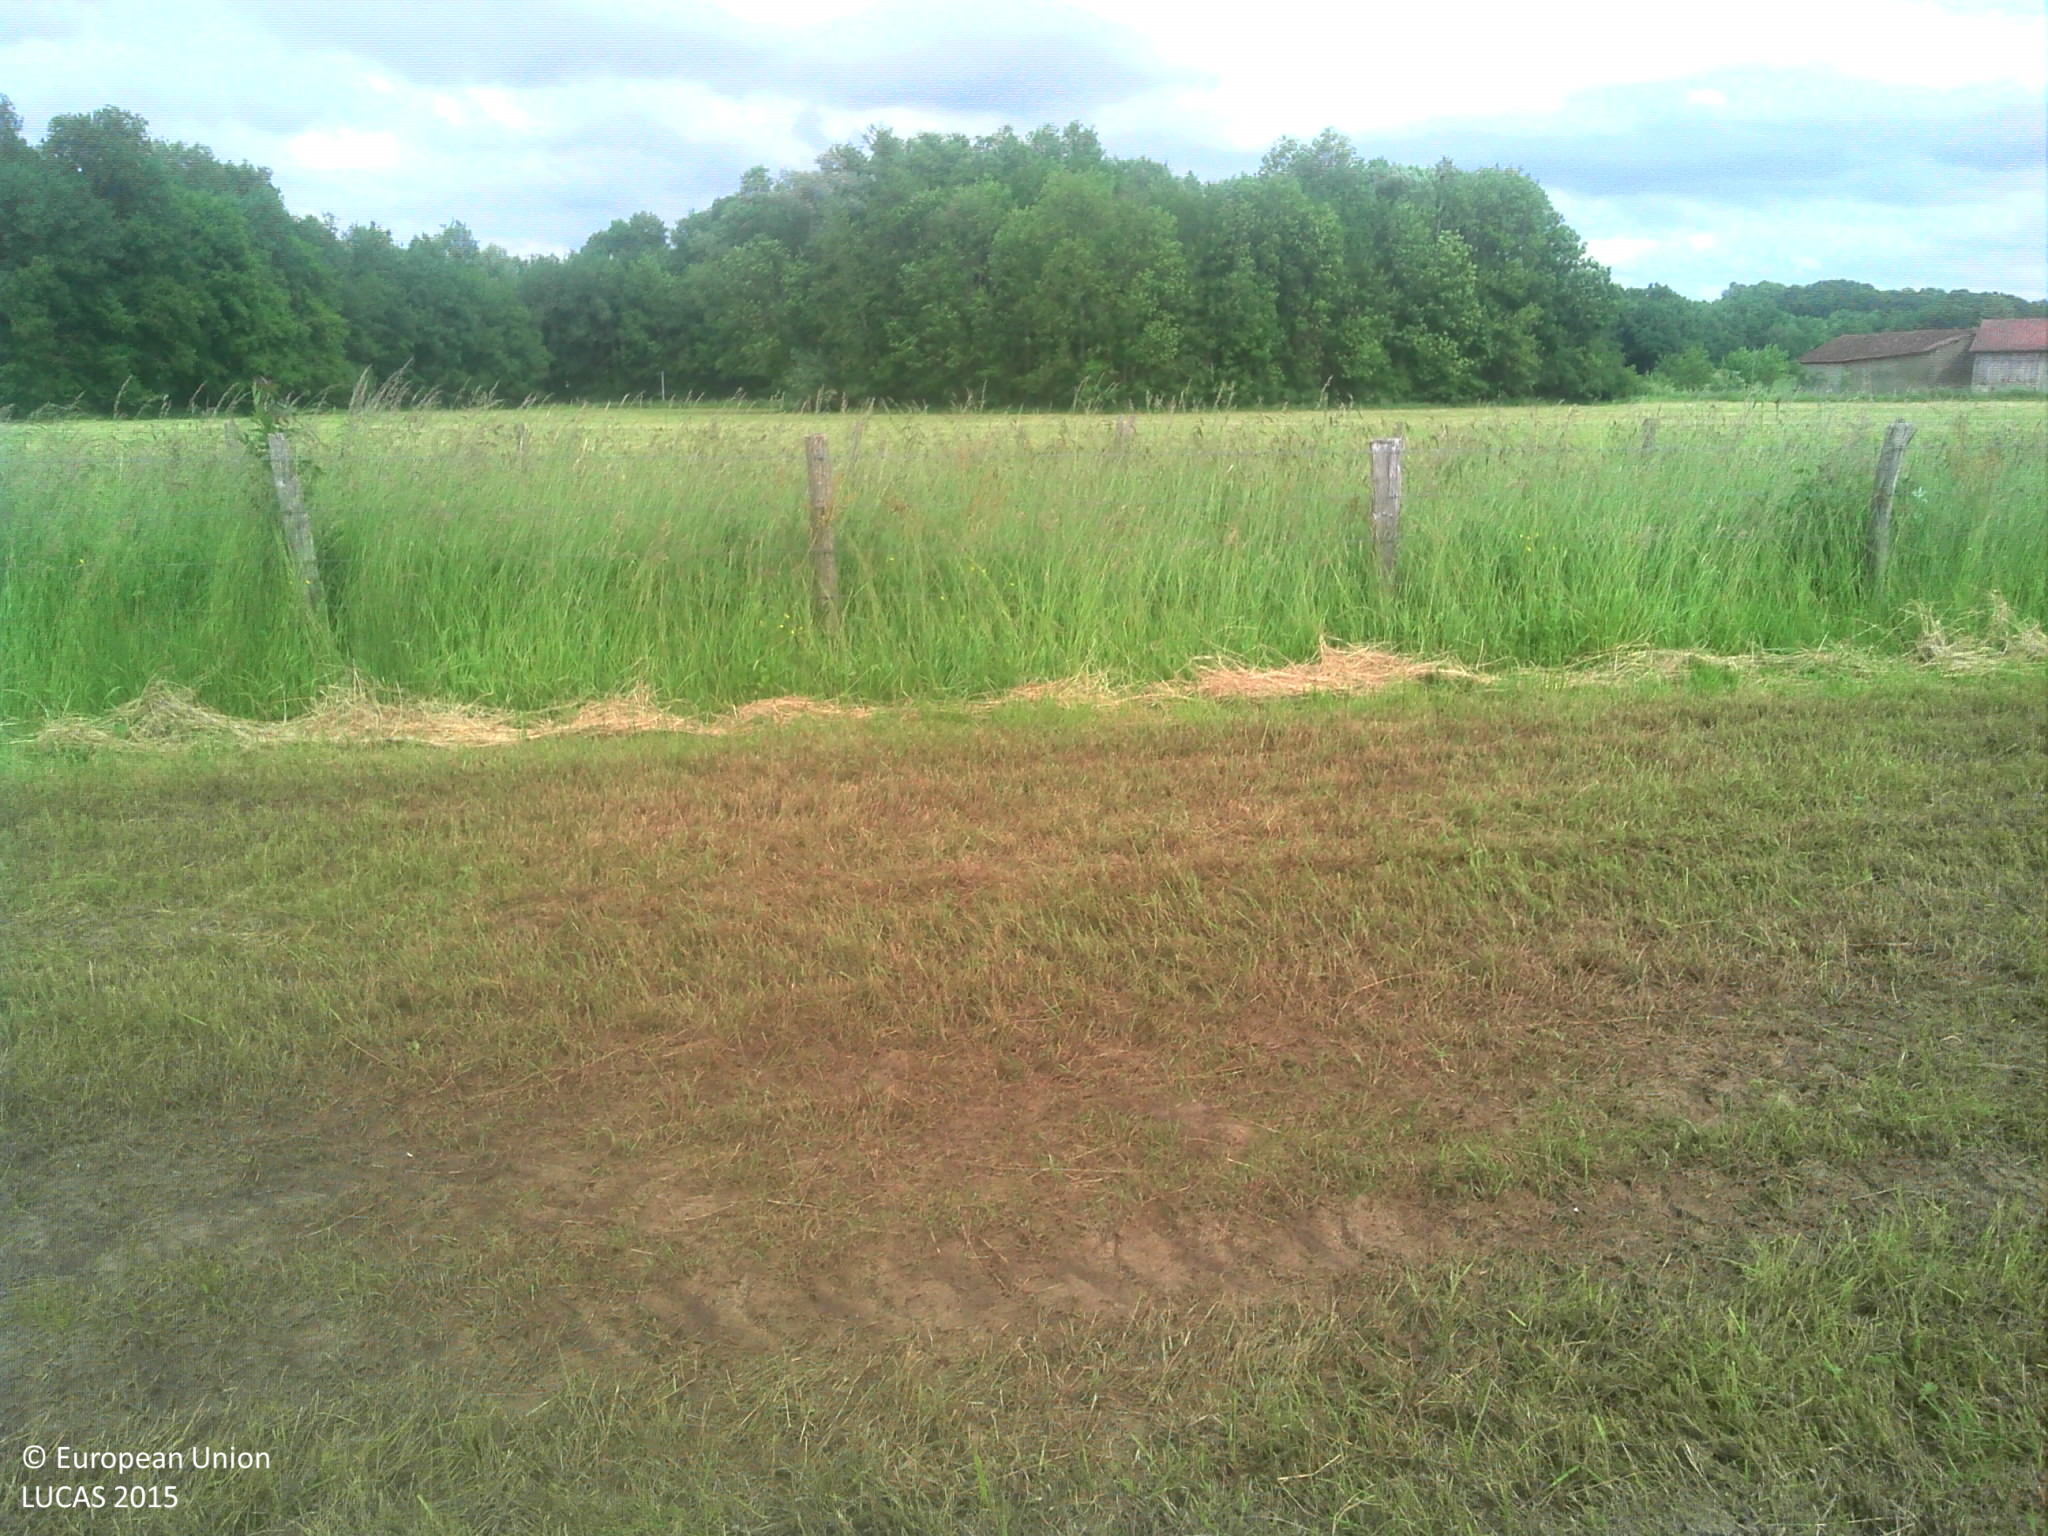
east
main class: Grassland
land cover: Grassland without tree/shrub cover
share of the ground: > 75 %
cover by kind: herbaceous plants 100 %
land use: Agriculture (excluding fallow land and kitchen gardens)
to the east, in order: Grassland without tree/shrub cover; Fences; Grass margins; Paved roads, cycling and walking lanes; Grass margins; Fences; Grassland without tree/shrub cover
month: June
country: FR
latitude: 48.4931
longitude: 4.7068
